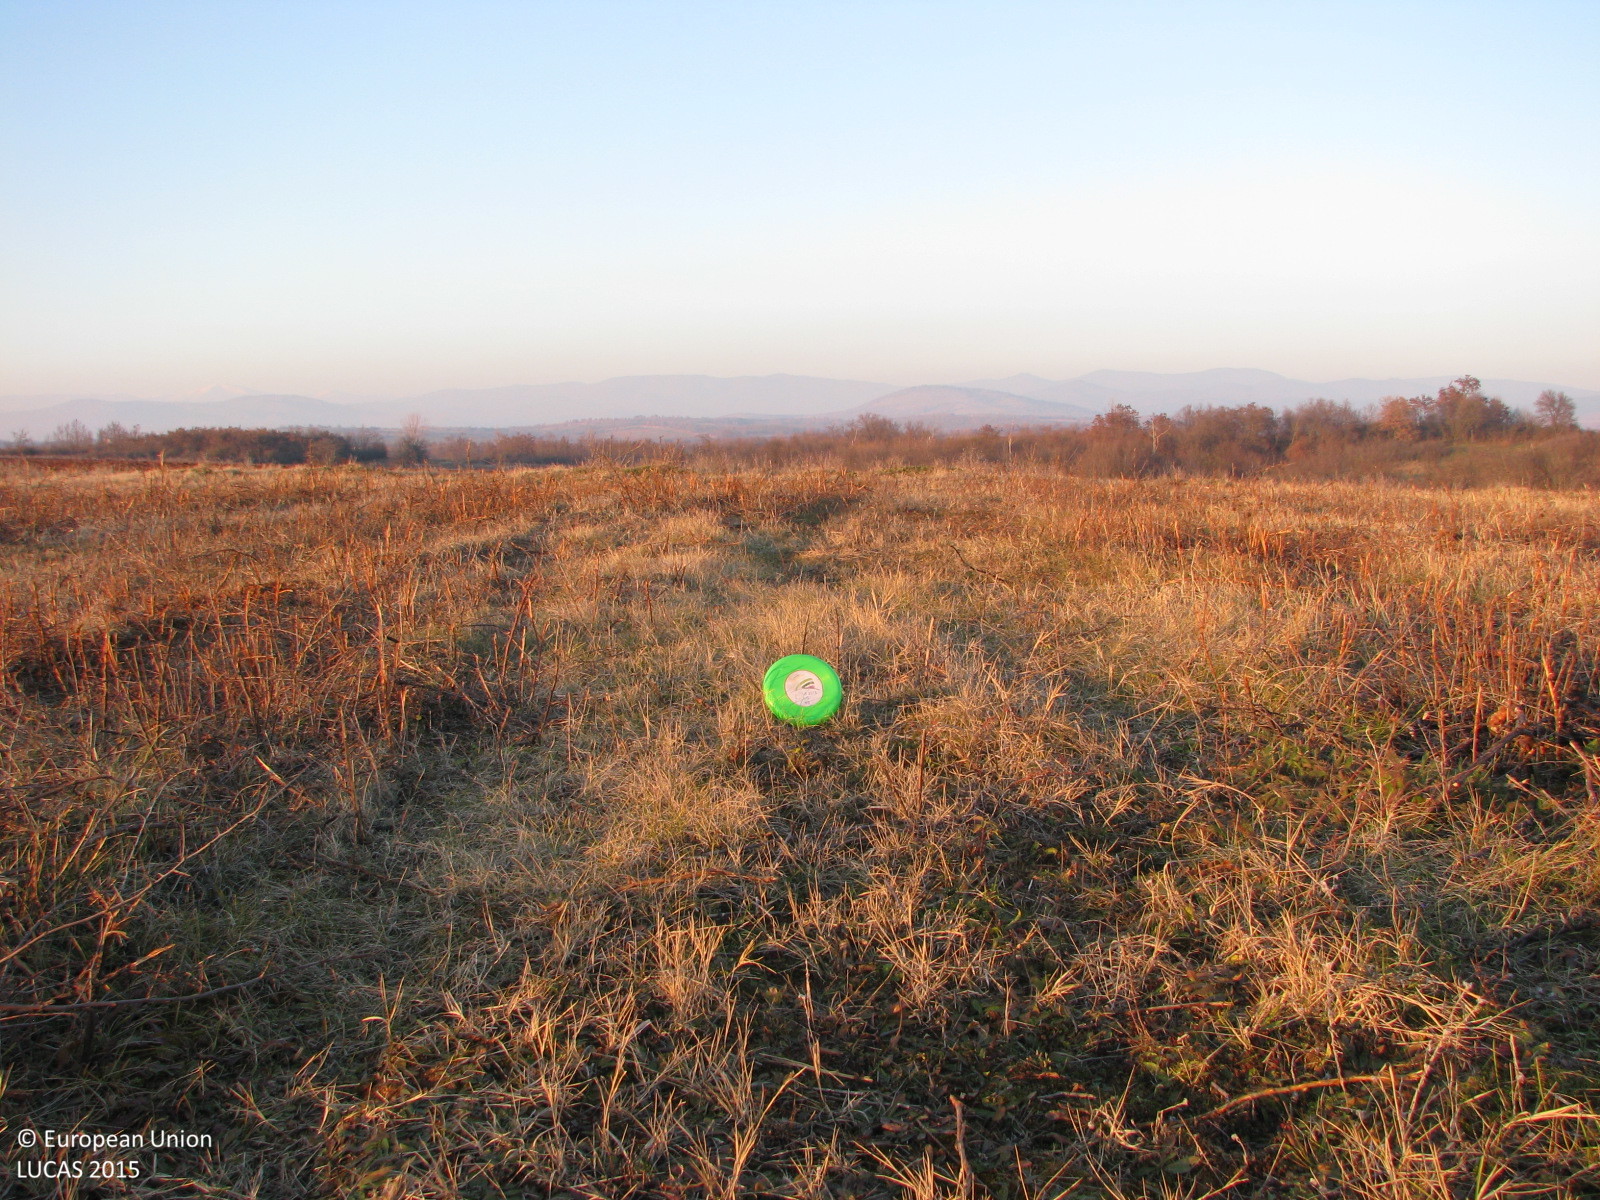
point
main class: Grassland
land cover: Grassland without tree/shrub cover
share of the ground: > 75 %
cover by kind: herbaceous plants 100 %
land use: Agriculture (excluding fallow land and kitchen gardens)
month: December
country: BG
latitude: 42.3399
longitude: 25.0987
